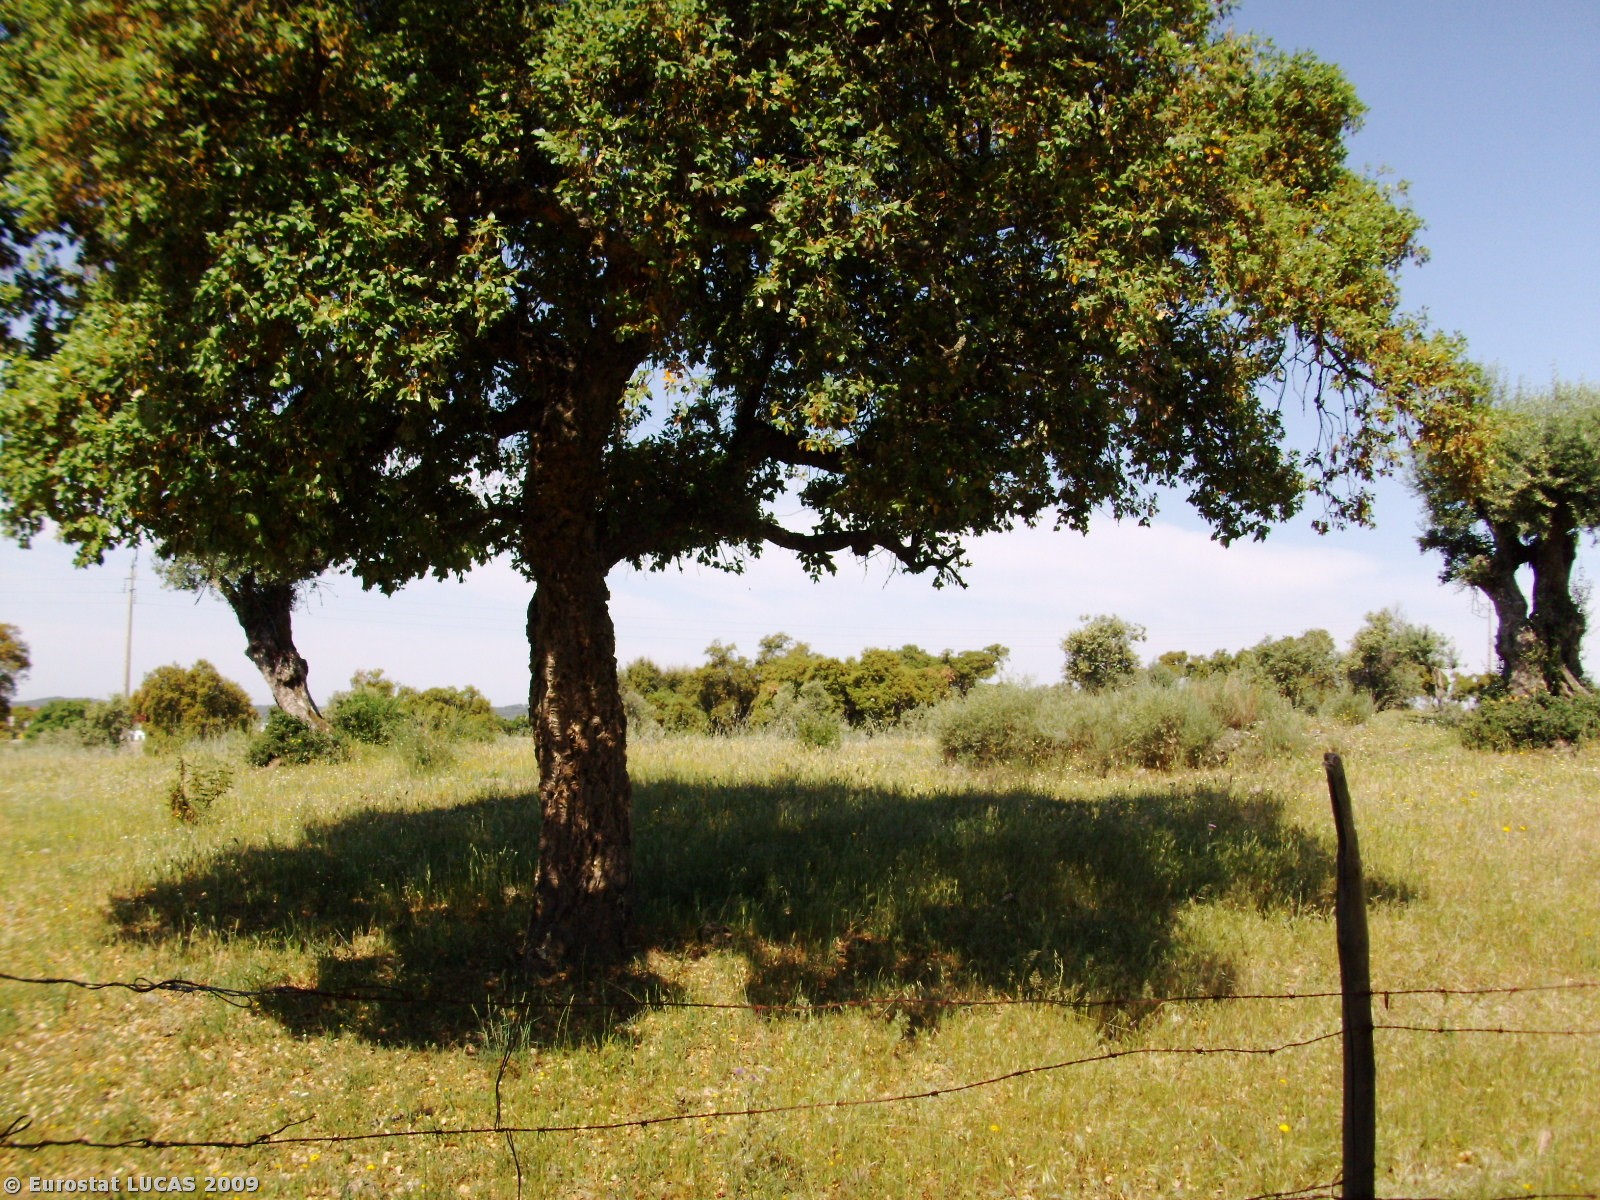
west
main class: Woodland
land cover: Broadleaved woodland
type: broadleaved evergreen forest
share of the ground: 25 - 50 %
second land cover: Grassland with sparse tree/shrub cover
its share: 50 - 75 %
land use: Forestry
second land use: Agriculture (excluding fallow land and kitchen gardens)
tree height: > 5 m
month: May
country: PT
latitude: 39.2685
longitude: -7.4150
